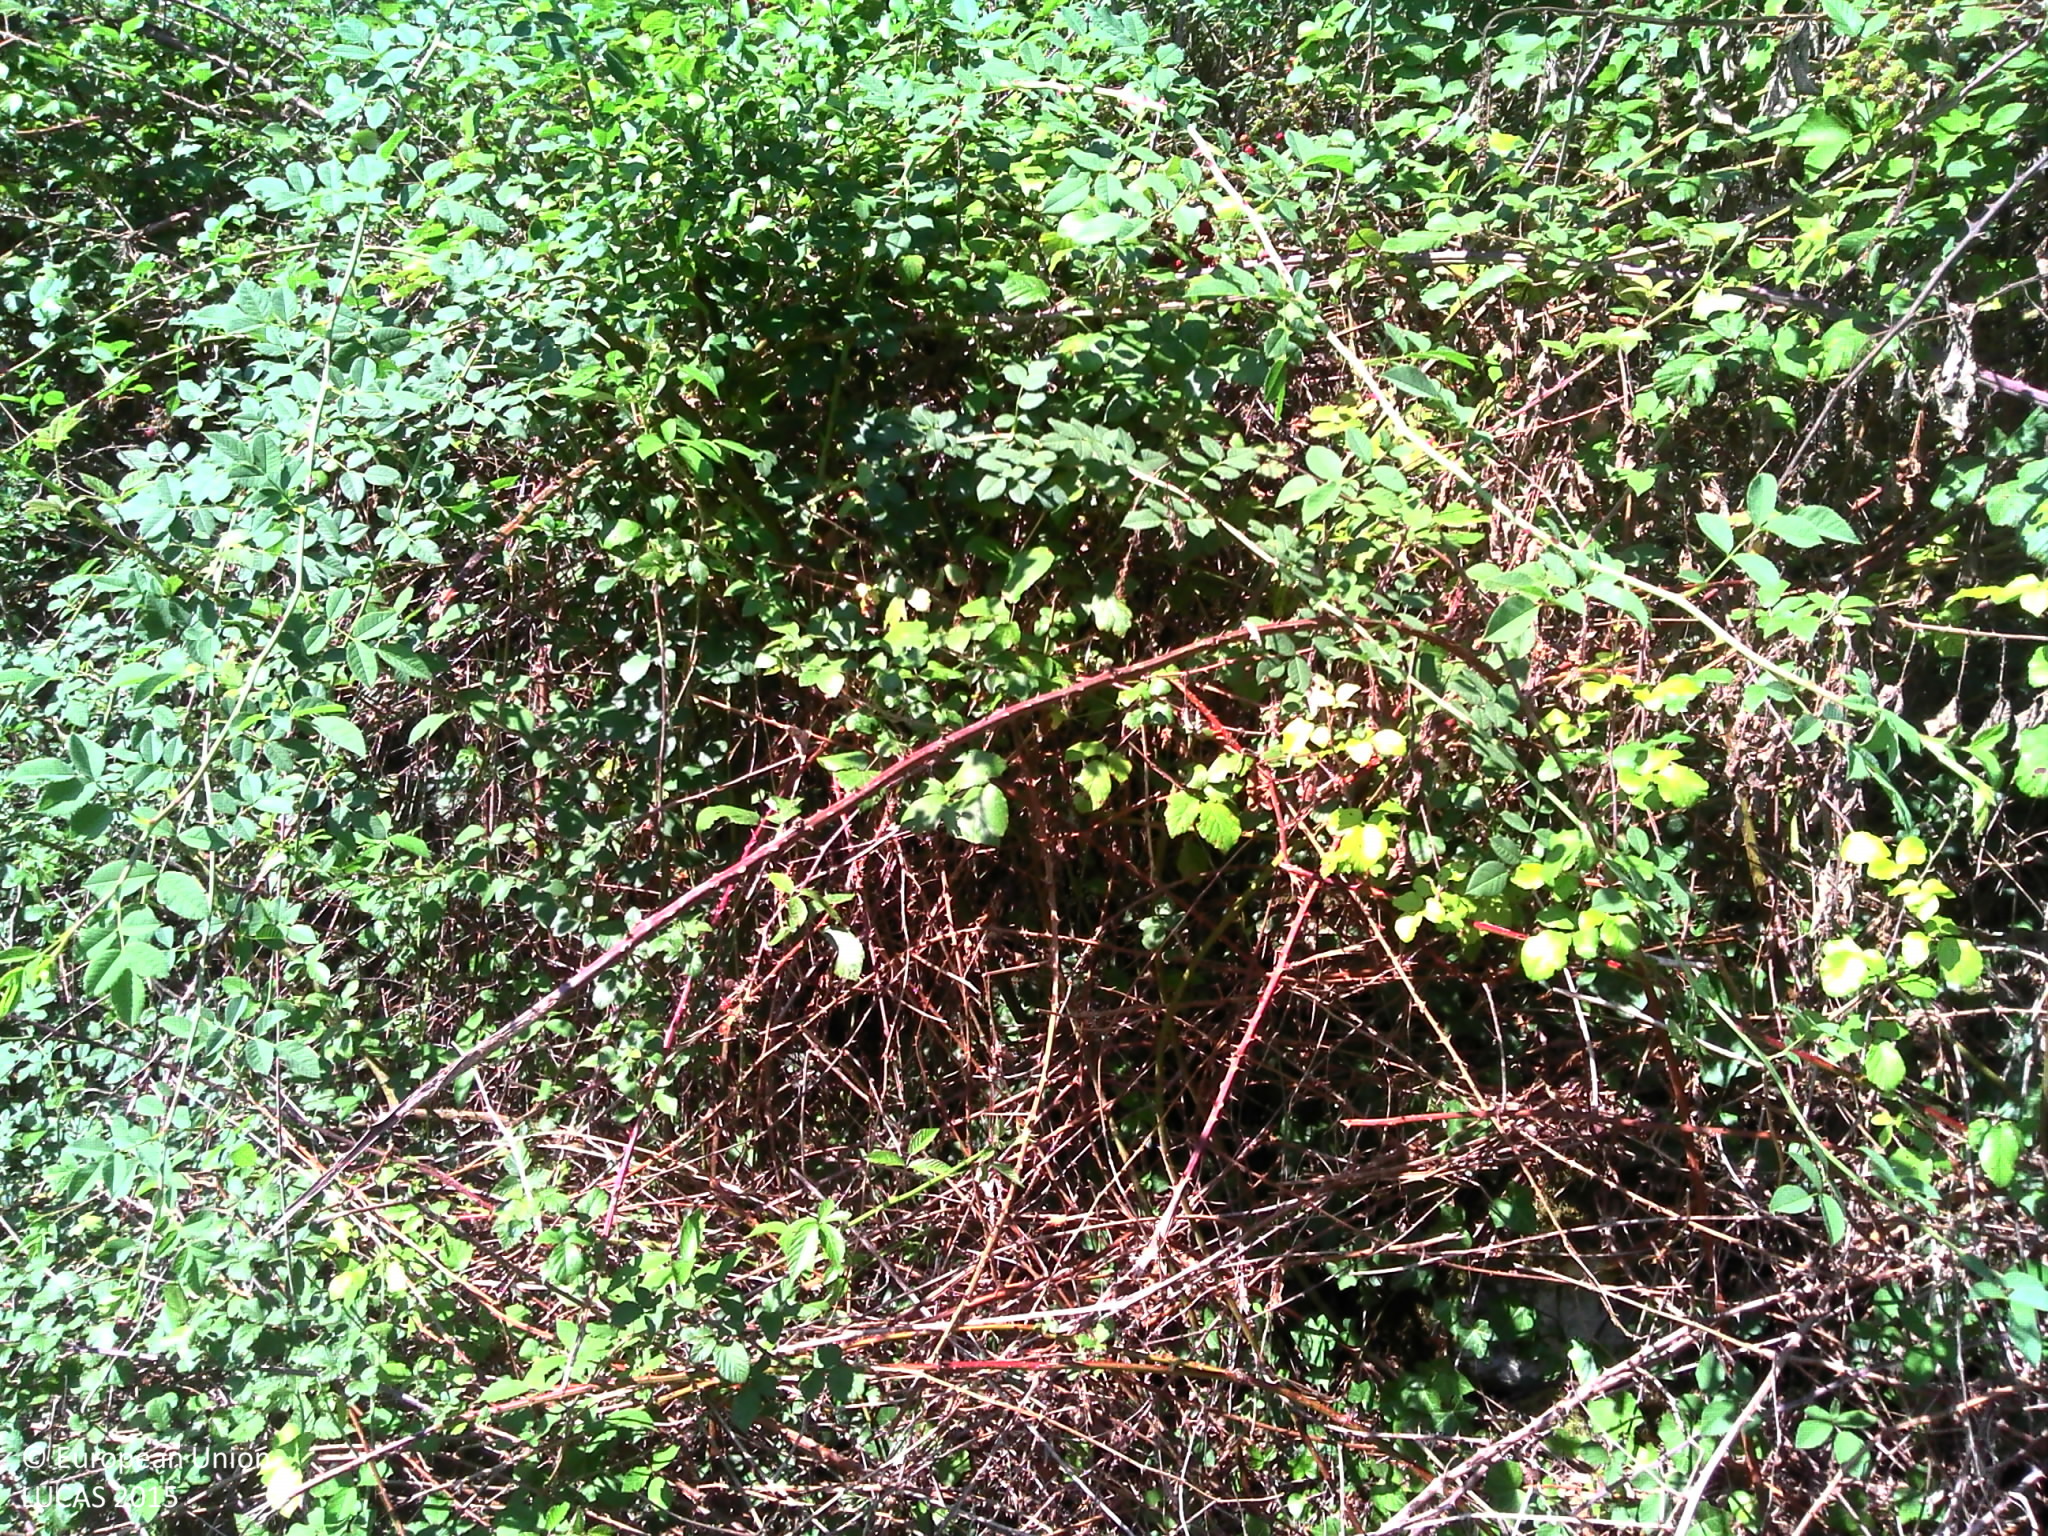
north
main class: Woodland
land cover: Broadleaved woodland
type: acidophilous oak and oak-birch forest
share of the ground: > 75 %
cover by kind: broadleaved forest trees 40 %, shrubs 30 %, herbaceous plants 20 %, unconsolidated bare surface 10 %
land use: Forestry
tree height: > 5 m
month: August
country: FR
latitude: 45.3943
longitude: 0.4194
